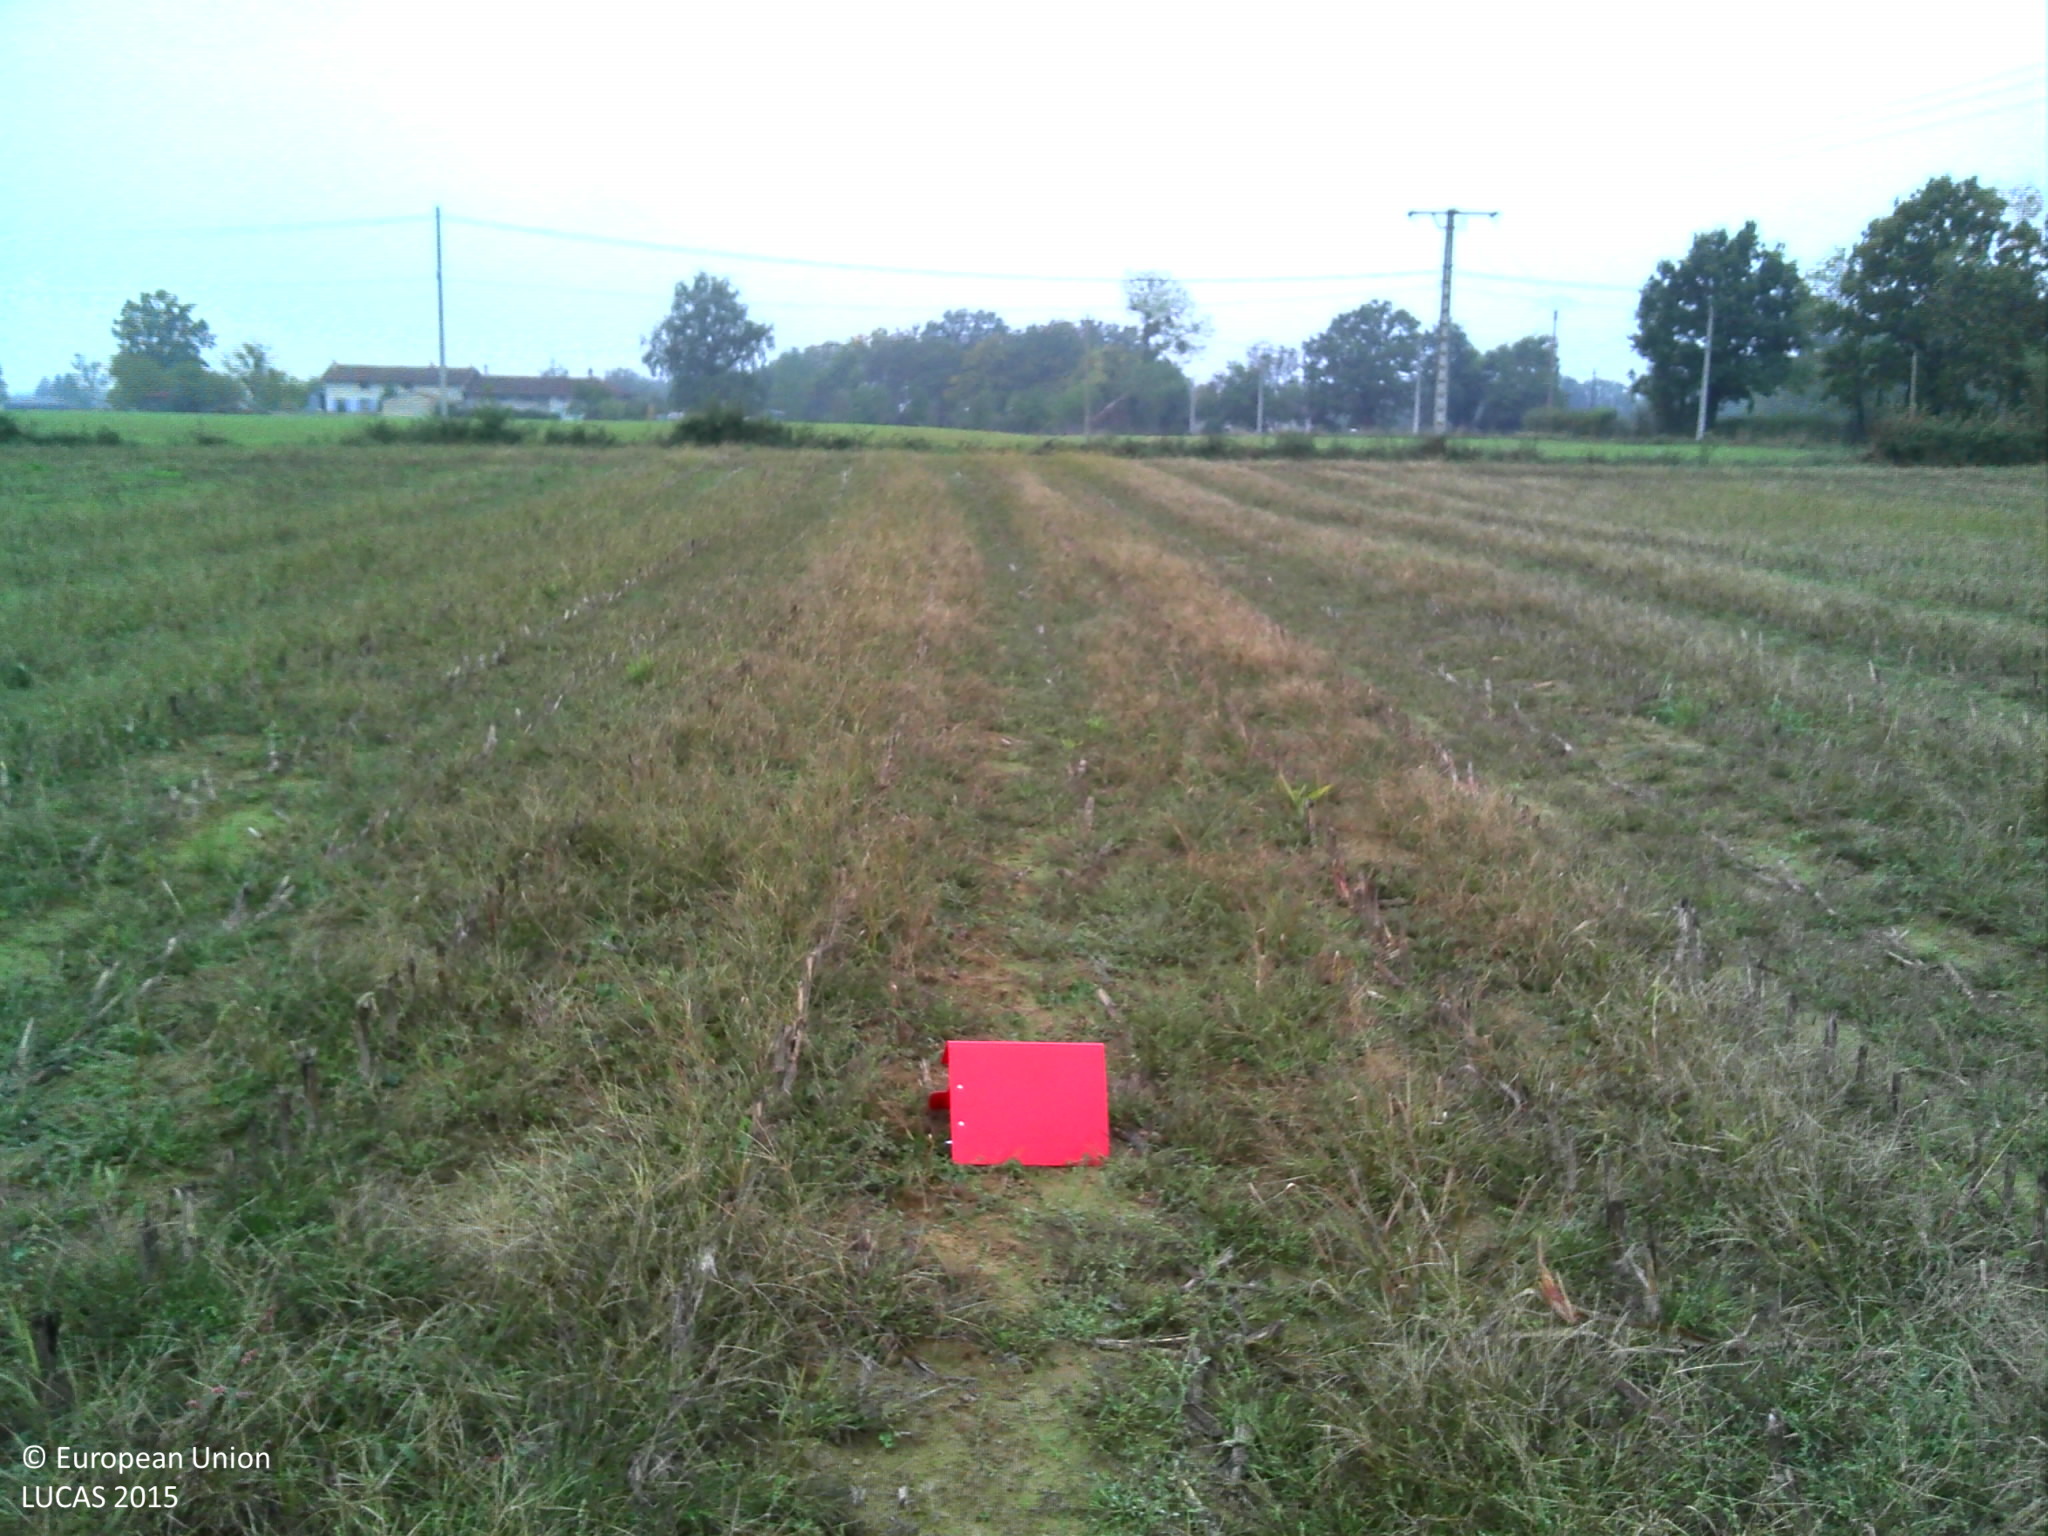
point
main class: Cropland
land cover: Maize
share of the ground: < 10 %
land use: Agriculture (excluding fallow land and kitchen gardens)
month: October
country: FR
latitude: 46.2947
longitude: 5.1346
